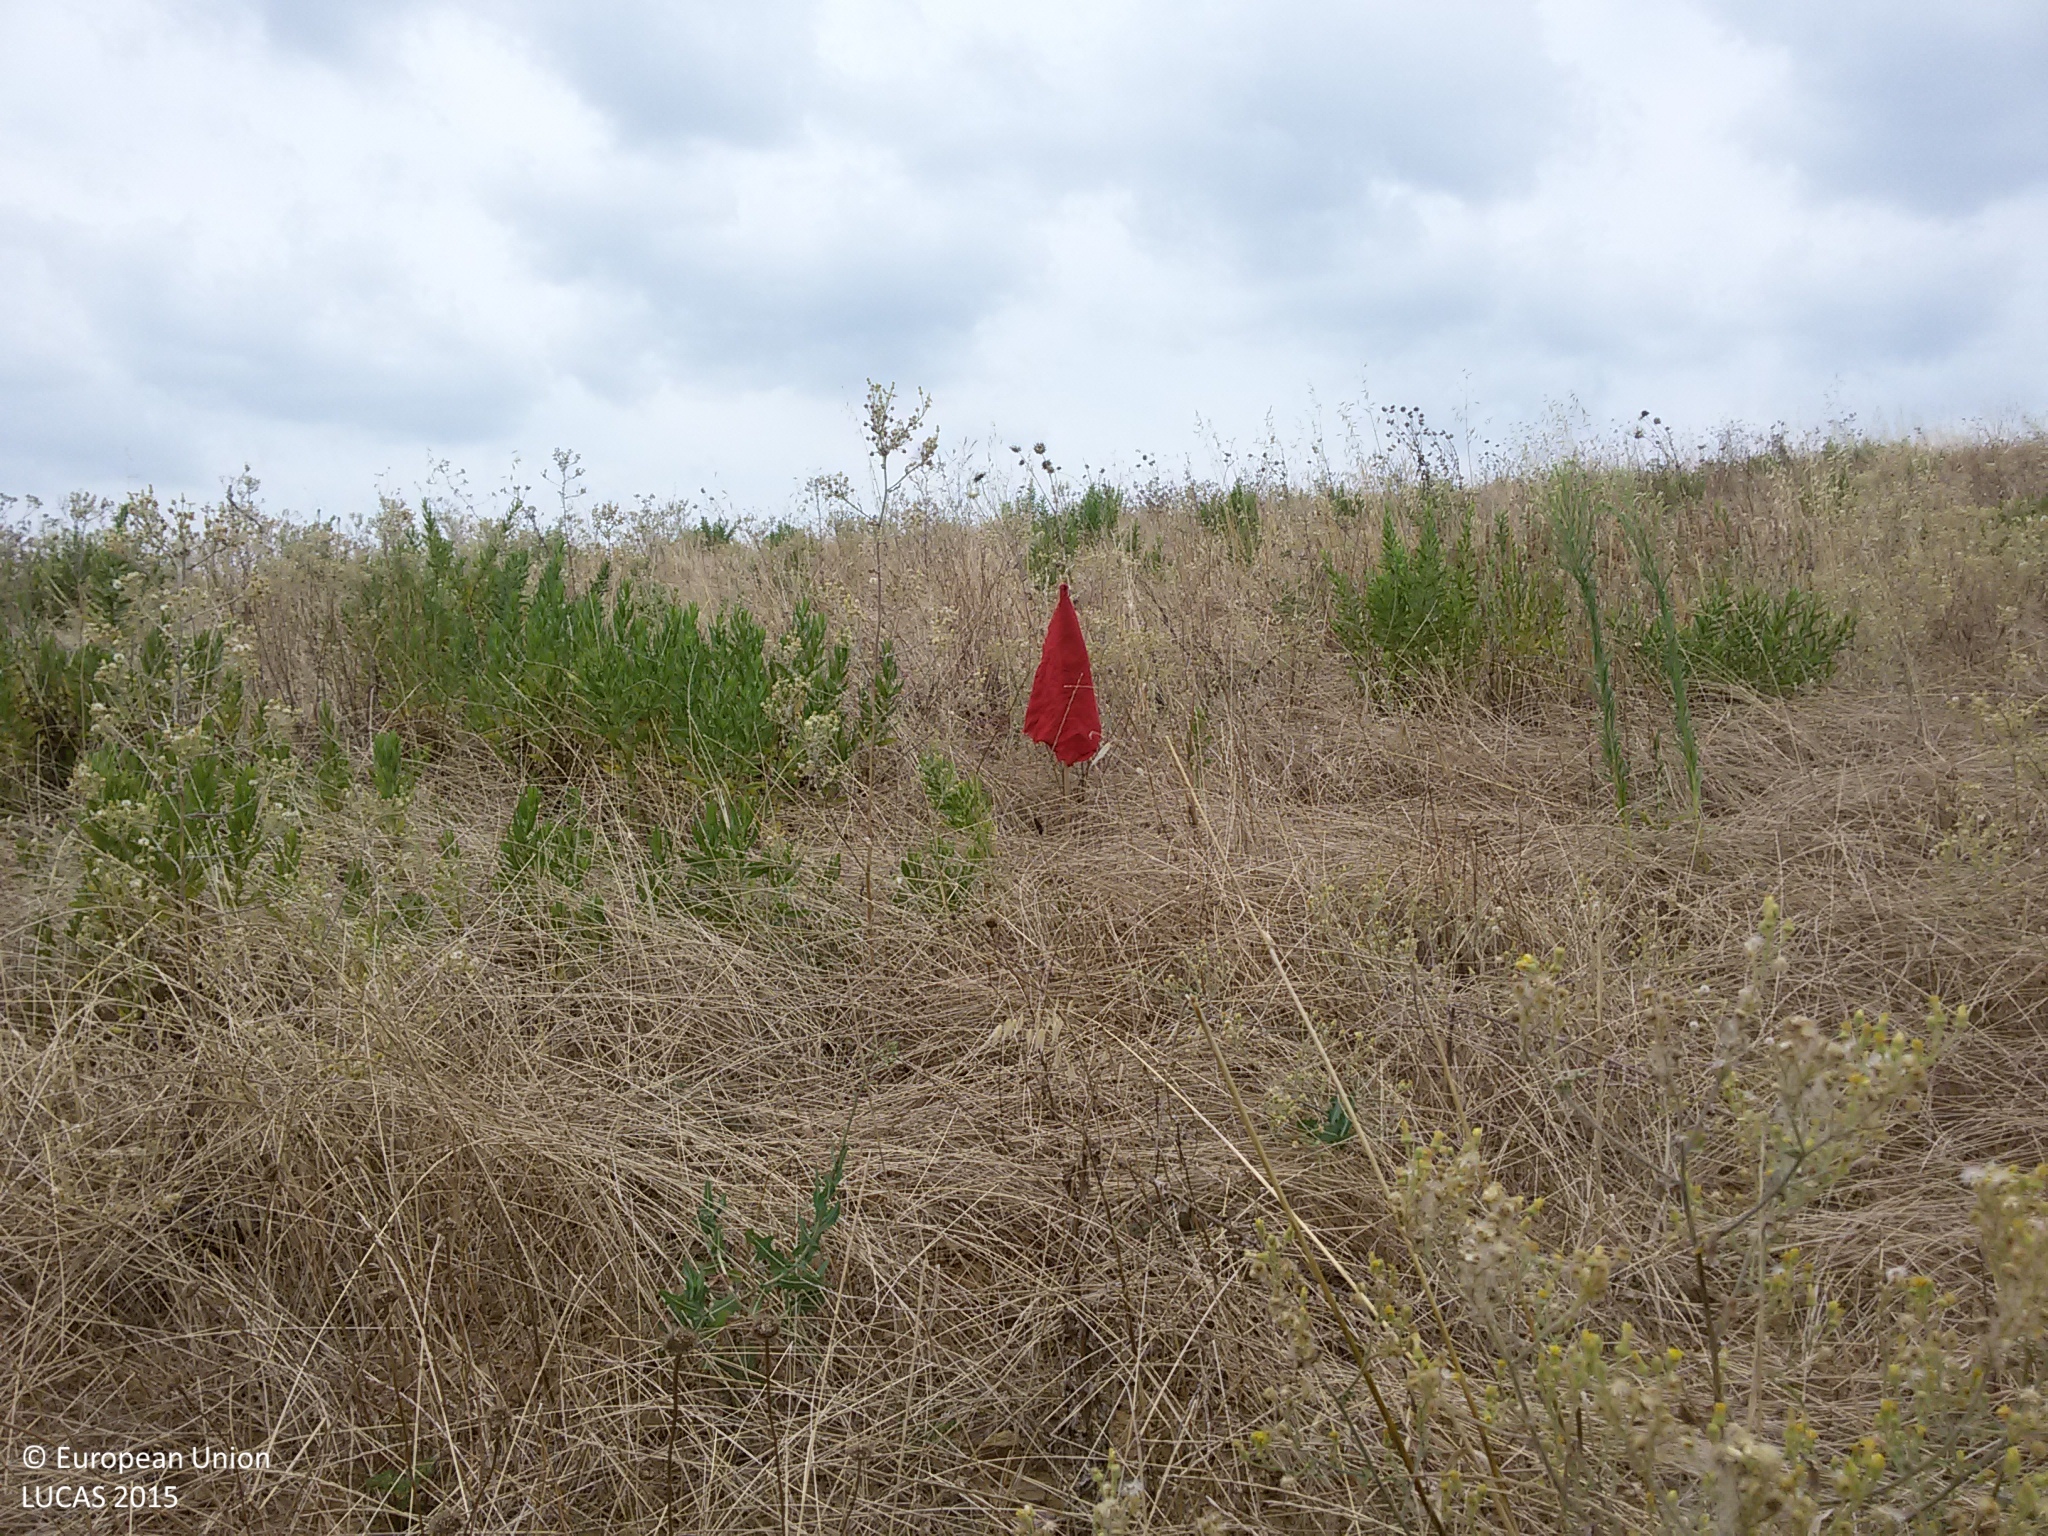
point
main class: Grassland
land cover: Grassland without tree/shrub cover
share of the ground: > 75 %
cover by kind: herbaceous plants 95 %, unconsolidated bare surface 5 %
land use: Agriculture (excluding fallow land and kitchen gardens)
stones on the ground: 25 - 50 %
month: July
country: IT
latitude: 42.7910
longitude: 11.2308
